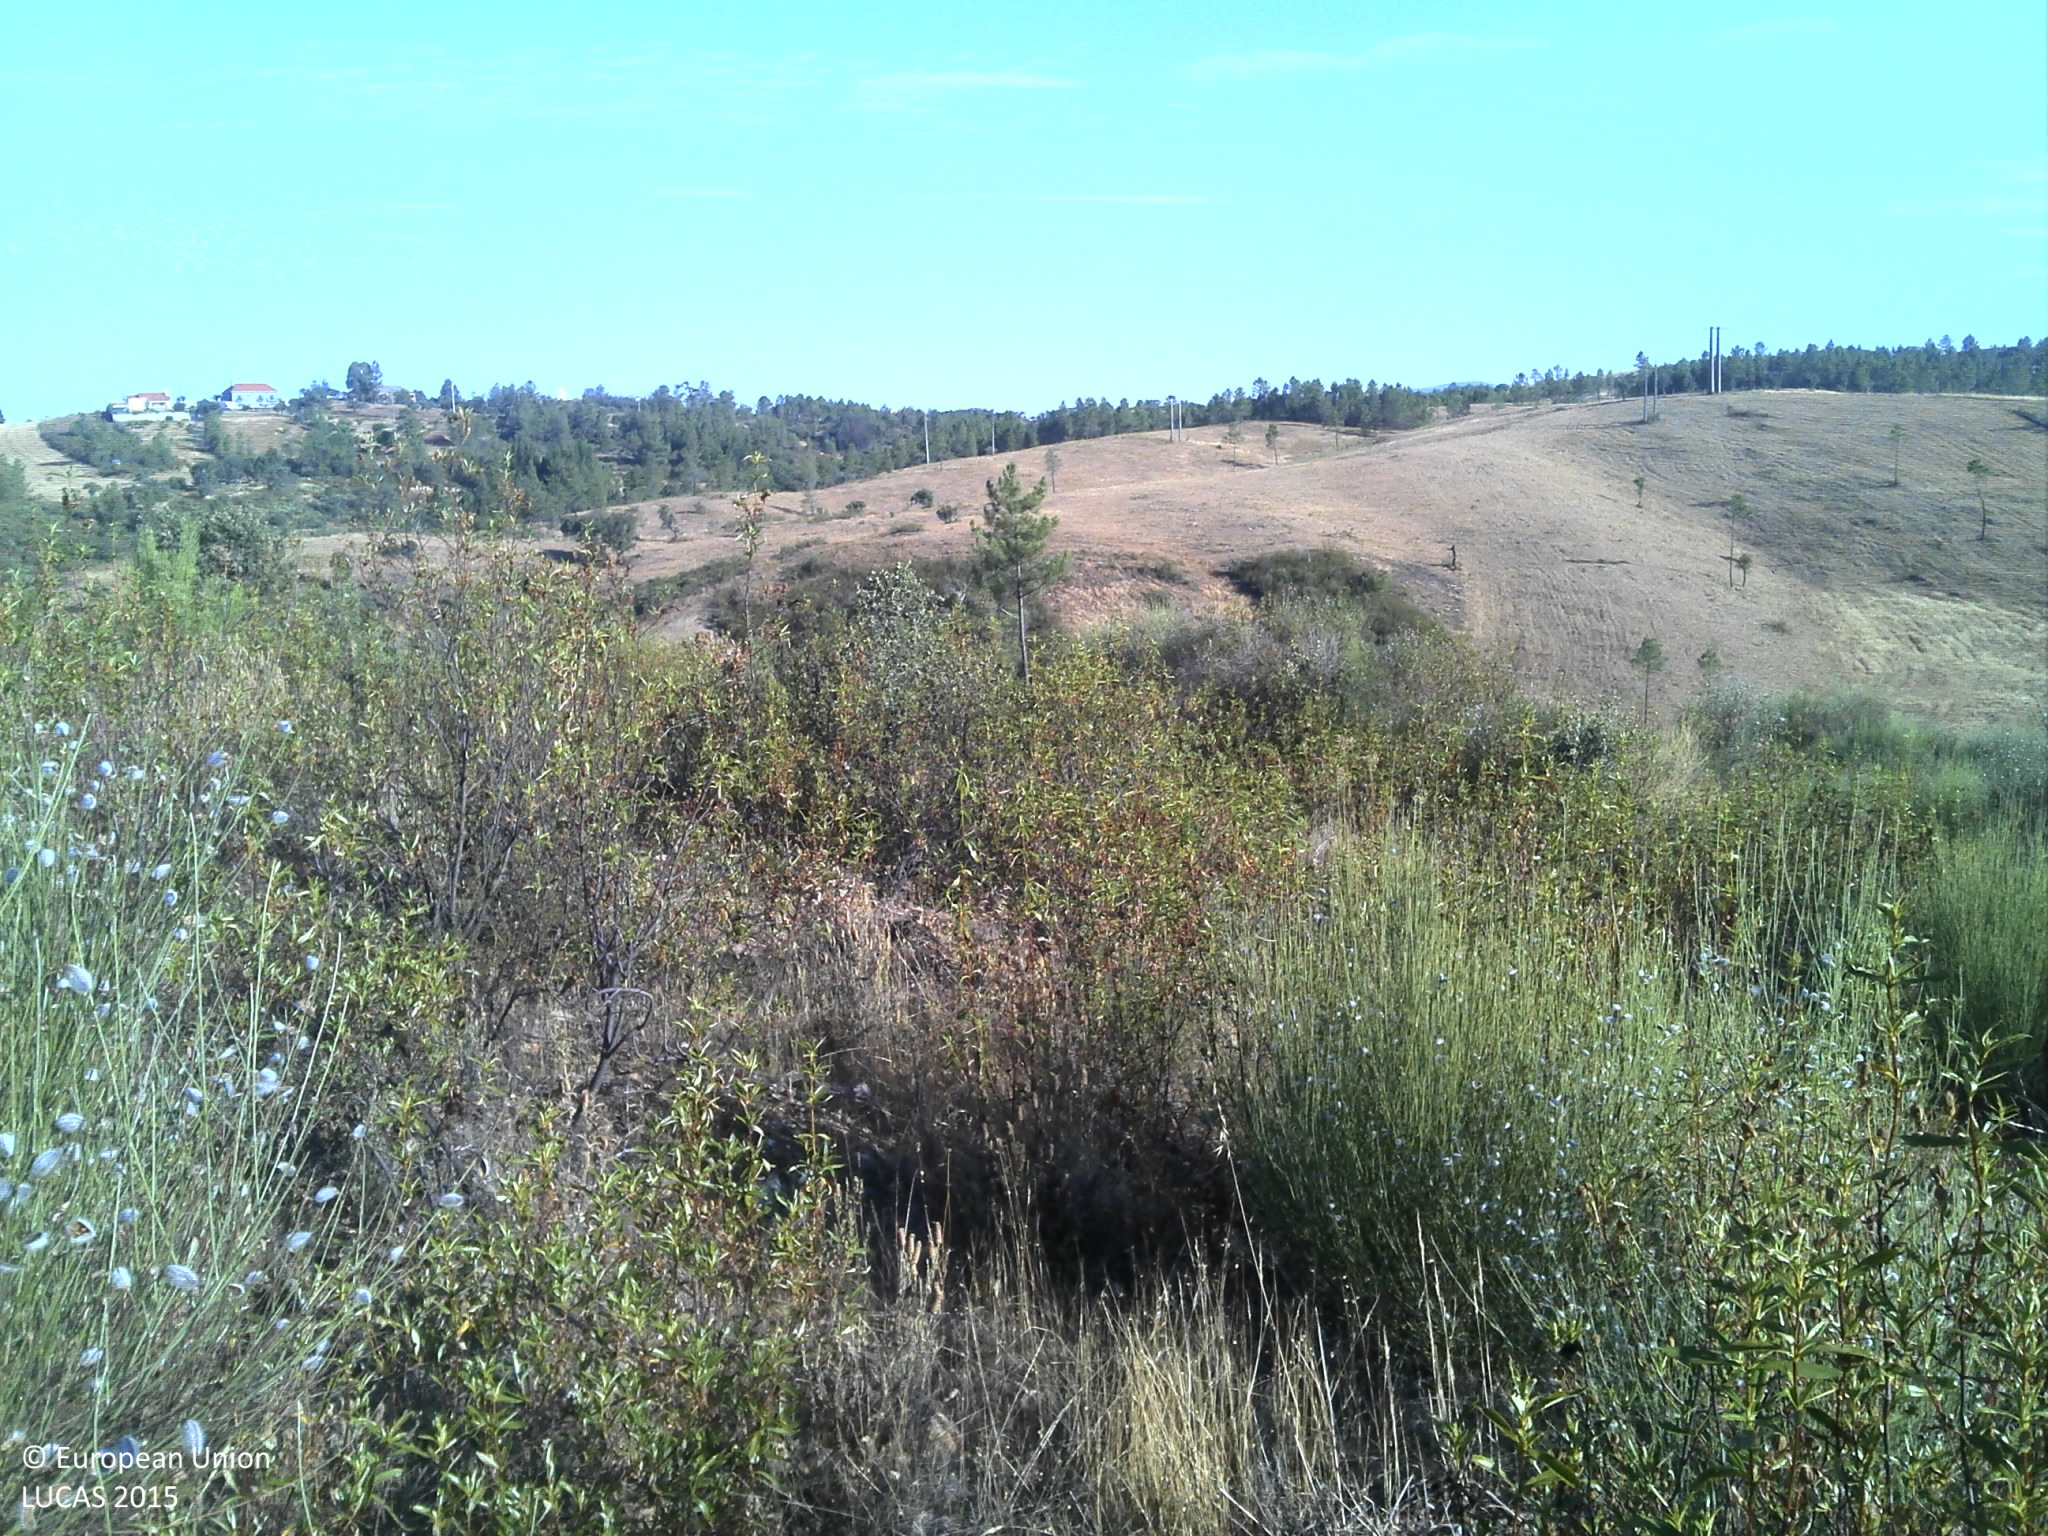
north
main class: Shrubland
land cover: Shrubland without tree cover
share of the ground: 50 - 75 %
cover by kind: shrubs 65 %, unconsolidated bare surface 15 %, herbaceous plants 10 %
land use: Semi-natural and natural areas not in use
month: July
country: PT
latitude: 39.8309
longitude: -7.5694
